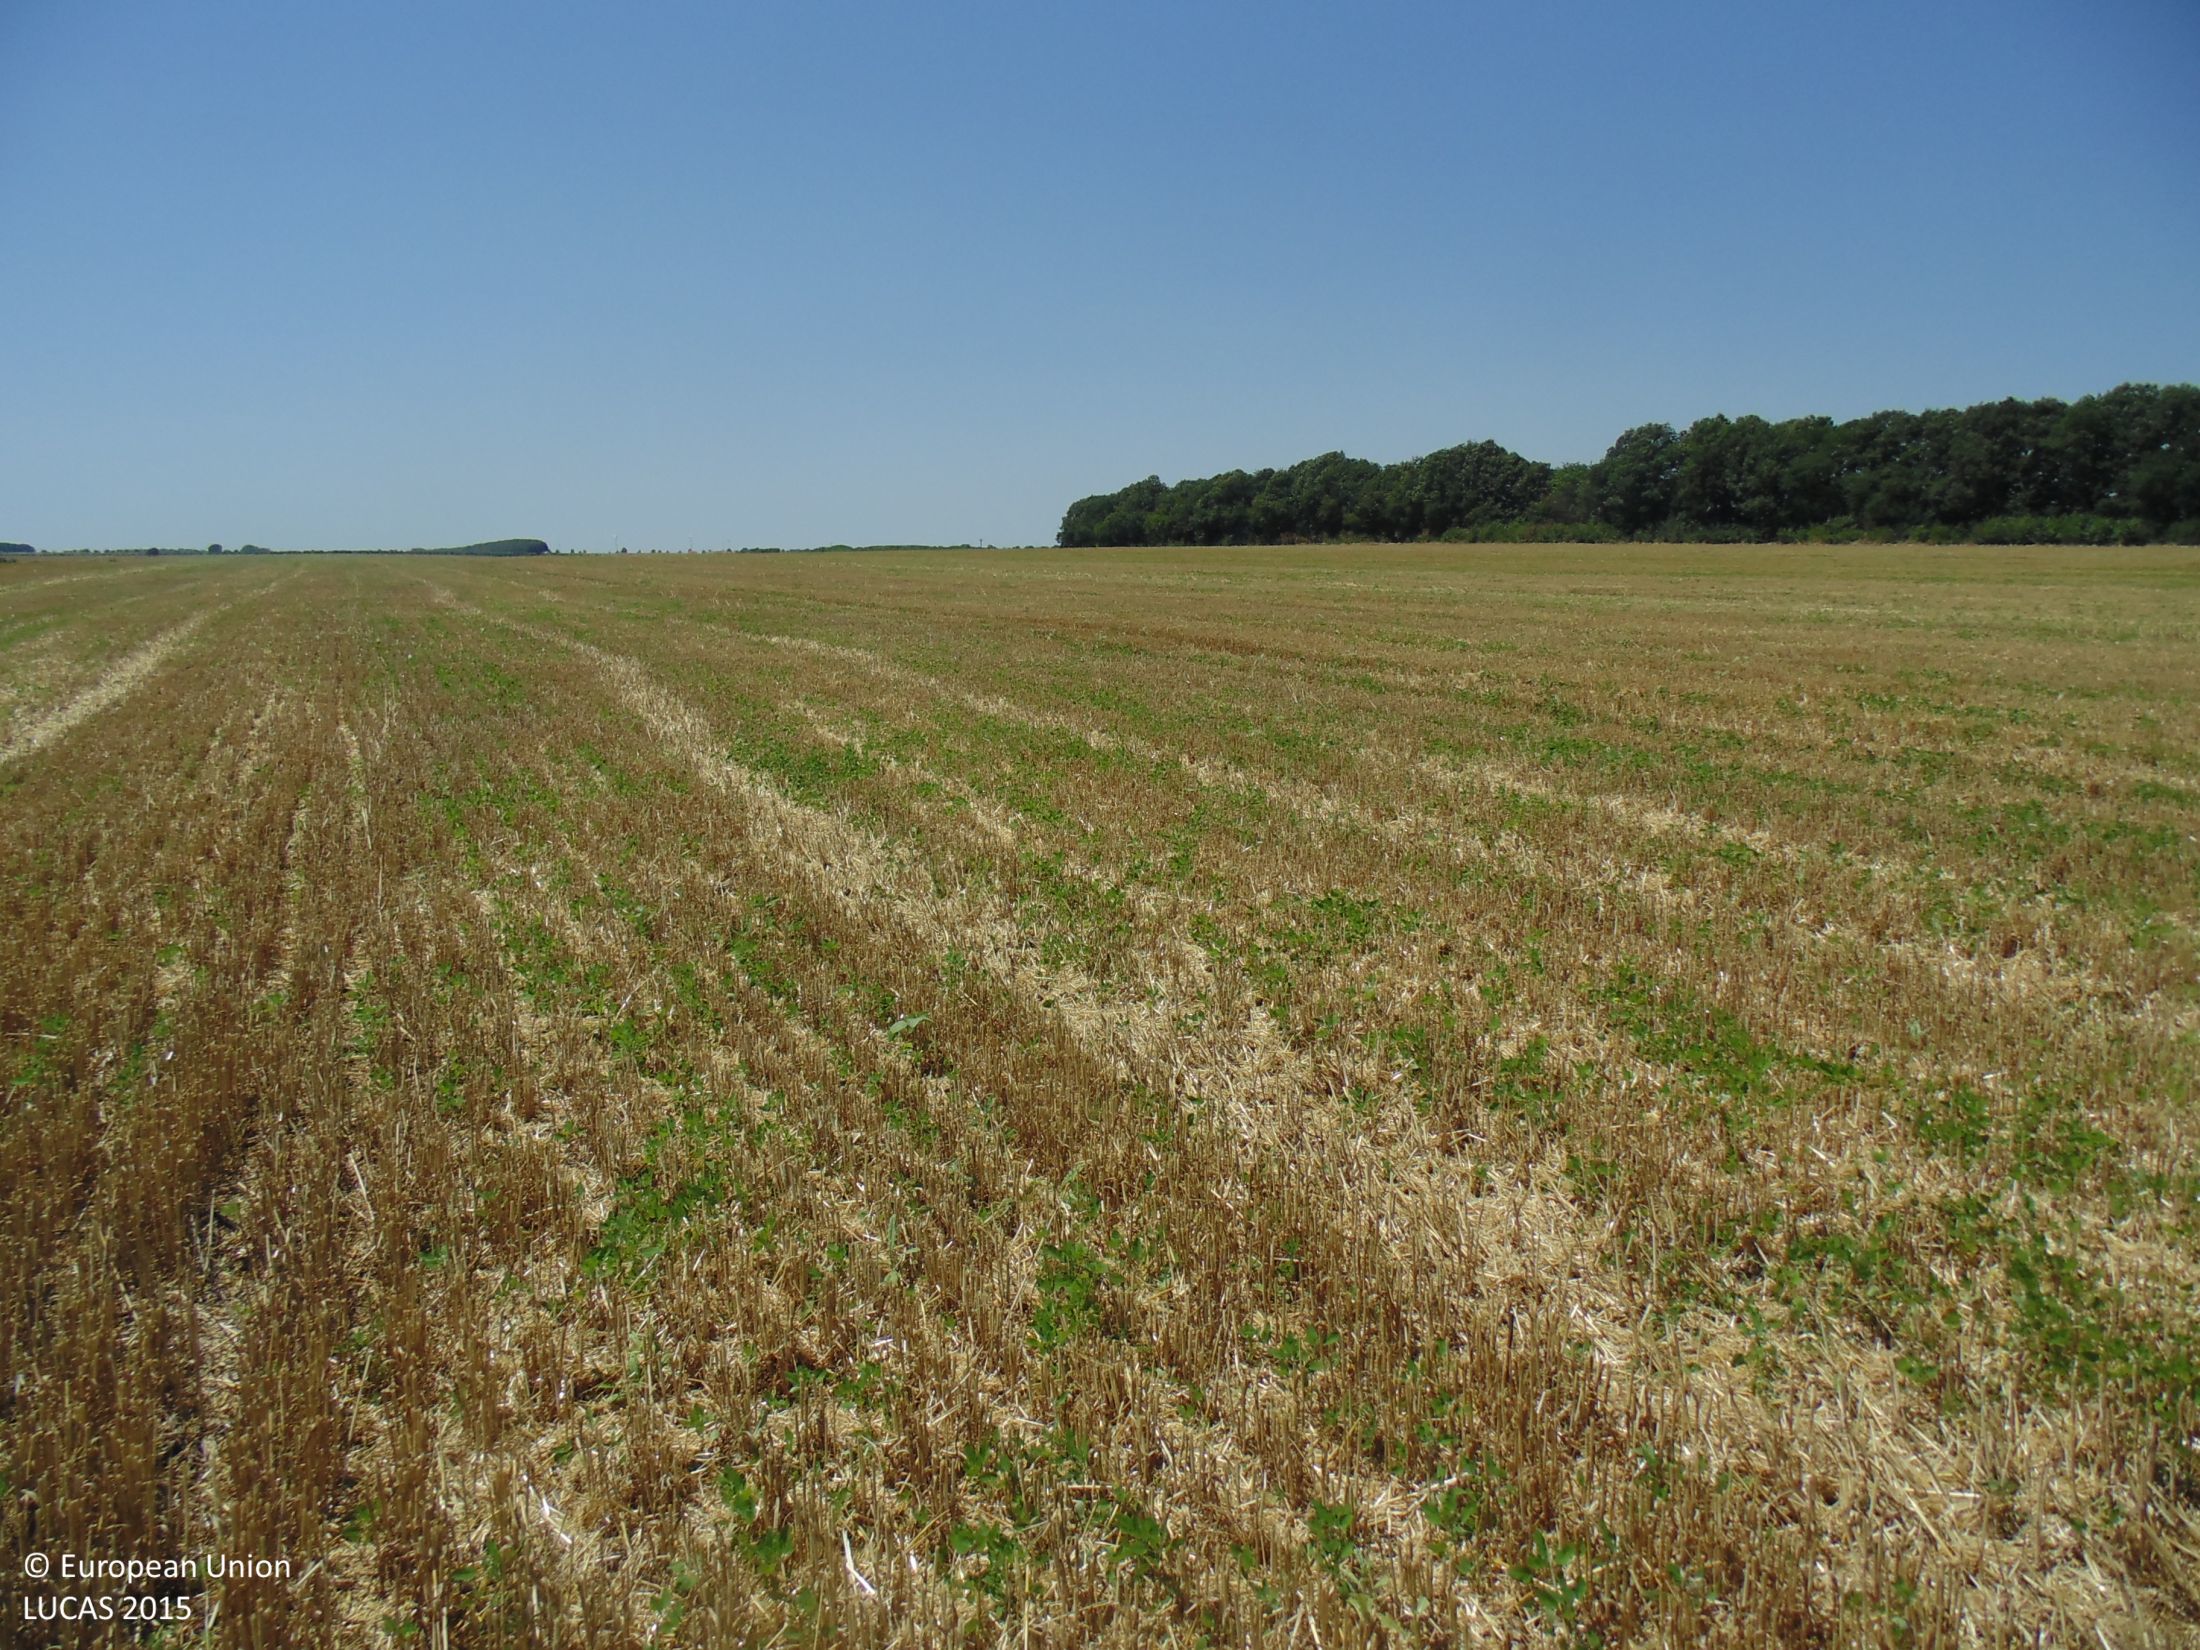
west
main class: Cropland
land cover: Common wheat
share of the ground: 25 - 50 %
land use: Agriculture (excluding fallow land and kitchen gardens)
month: July
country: BG
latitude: 43.4696
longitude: 28.1604
